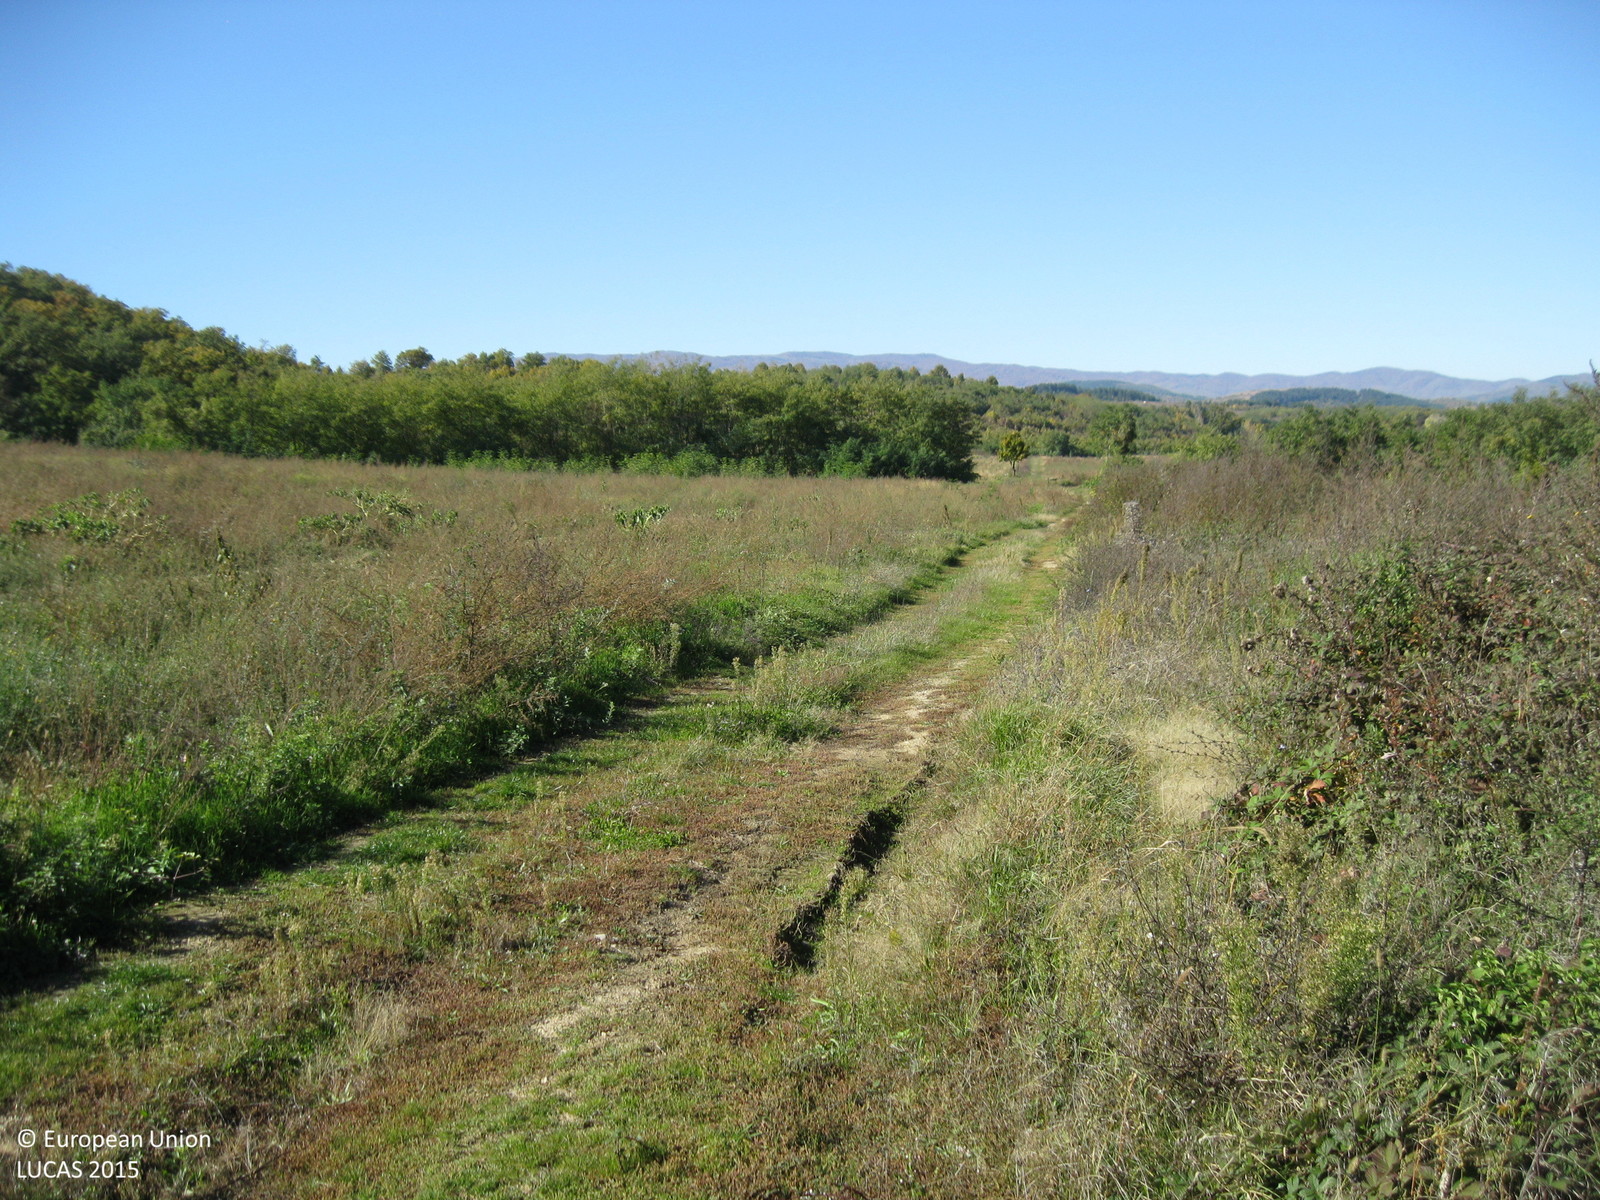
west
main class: Shrubland
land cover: Shrubland without tree cover
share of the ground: > 75 %
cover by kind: shrubs 90 %, herbaceous plants 10 %
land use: Fallow land
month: November
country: BG
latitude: 42.3591
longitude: 24.0900
